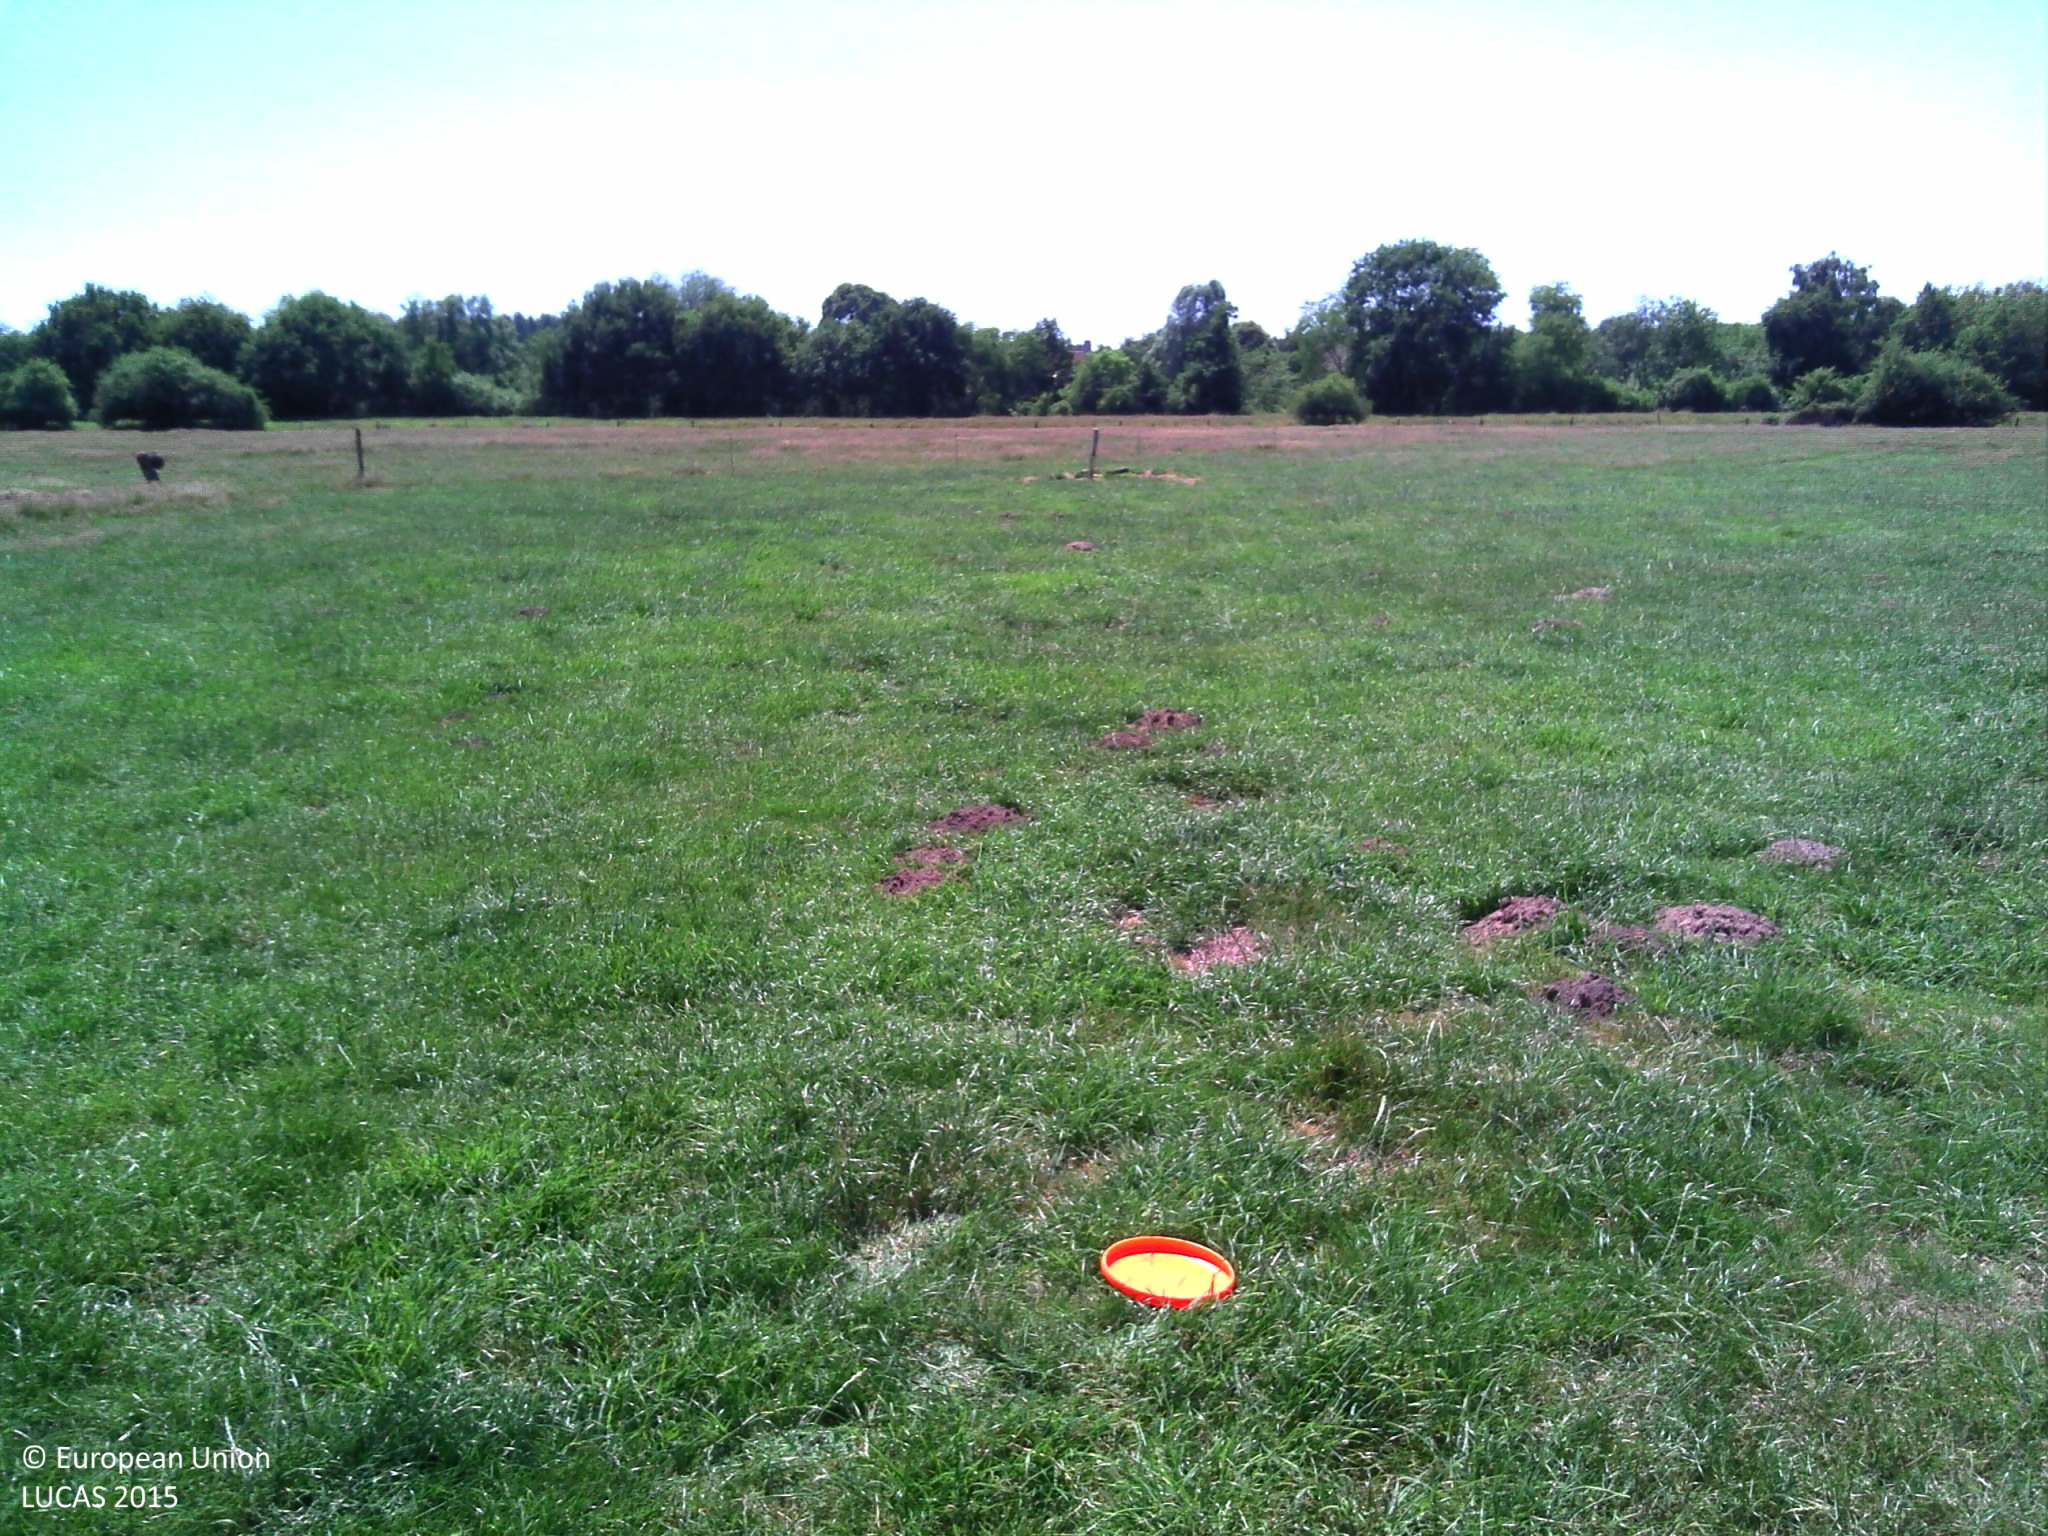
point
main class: Grassland
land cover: Grassland without tree/shrub cover
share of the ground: > 75 %
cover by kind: herbaceous plants 100 %
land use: Agriculture (excluding fallow land and kitchen gardens)
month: July
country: BE
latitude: 51.1119
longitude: 3.4068
